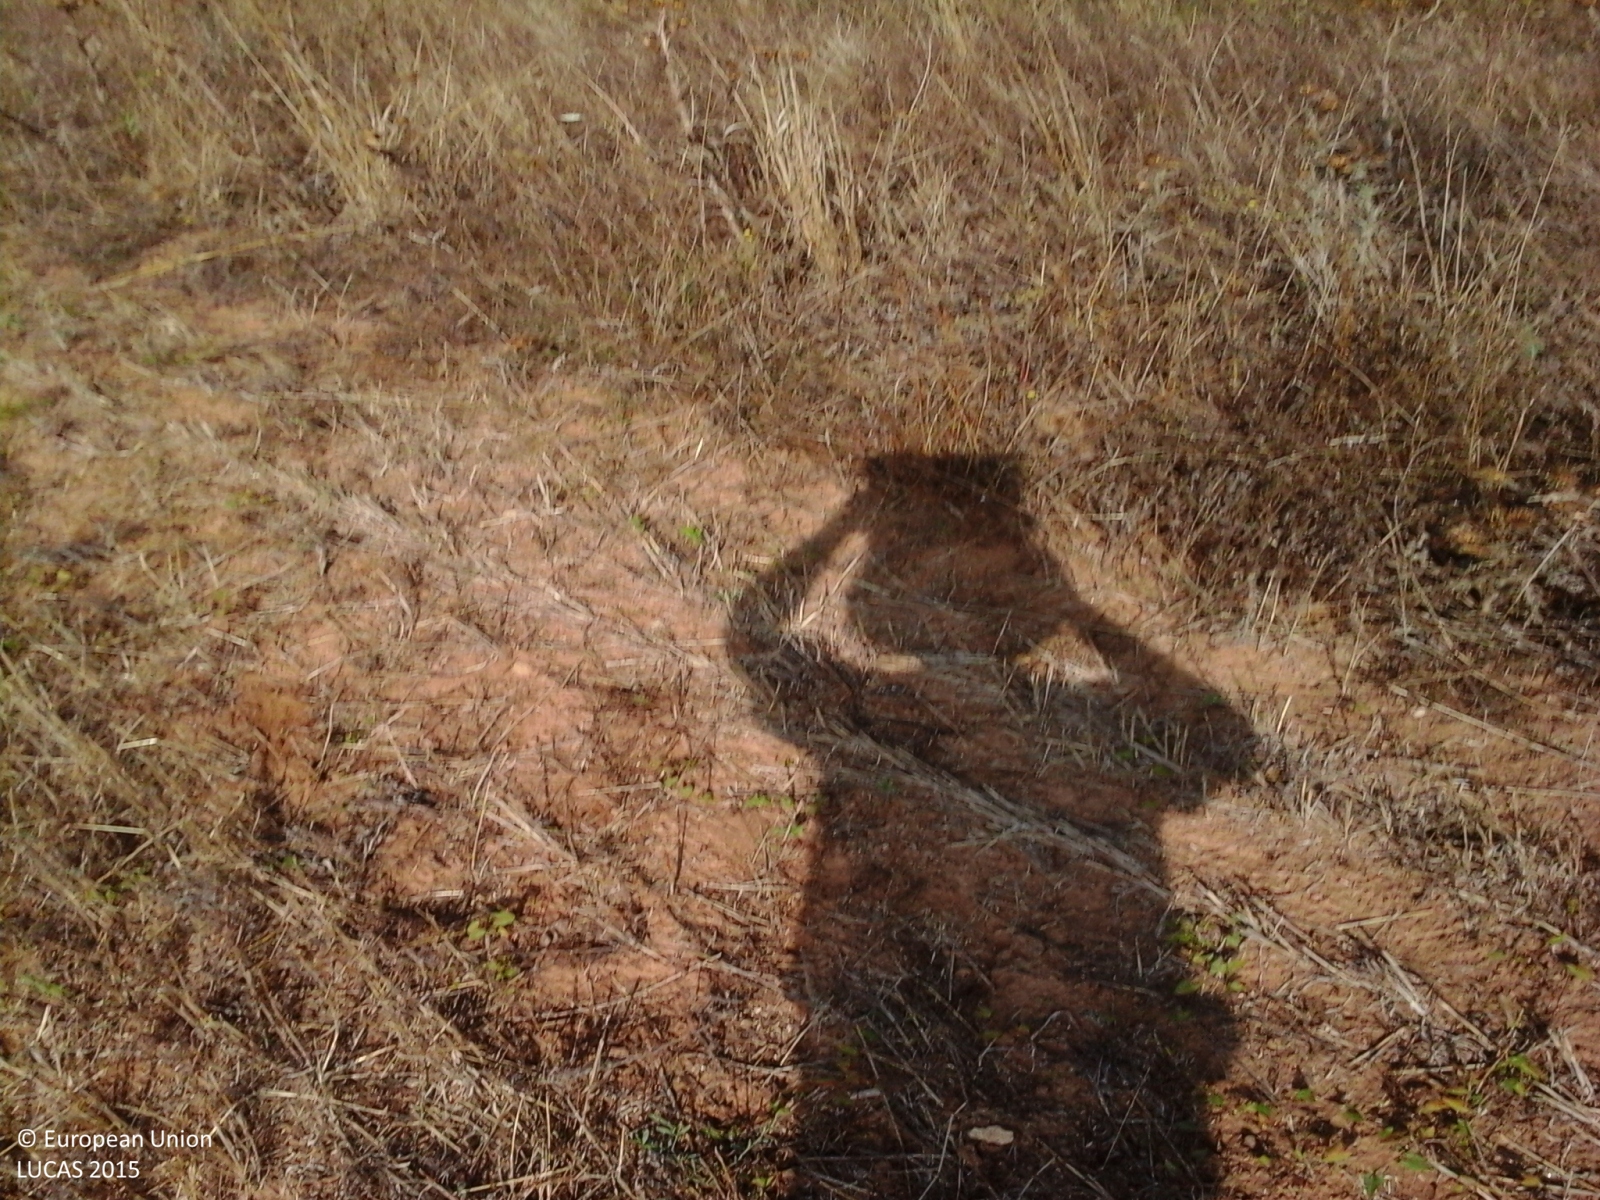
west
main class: Cropland
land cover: Temporary grasslands
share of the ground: > 75 %
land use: Agriculture (excluding fallow land and kitchen gardens)
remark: Harvested field
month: August
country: IT
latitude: 42.5689
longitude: 11.6148
